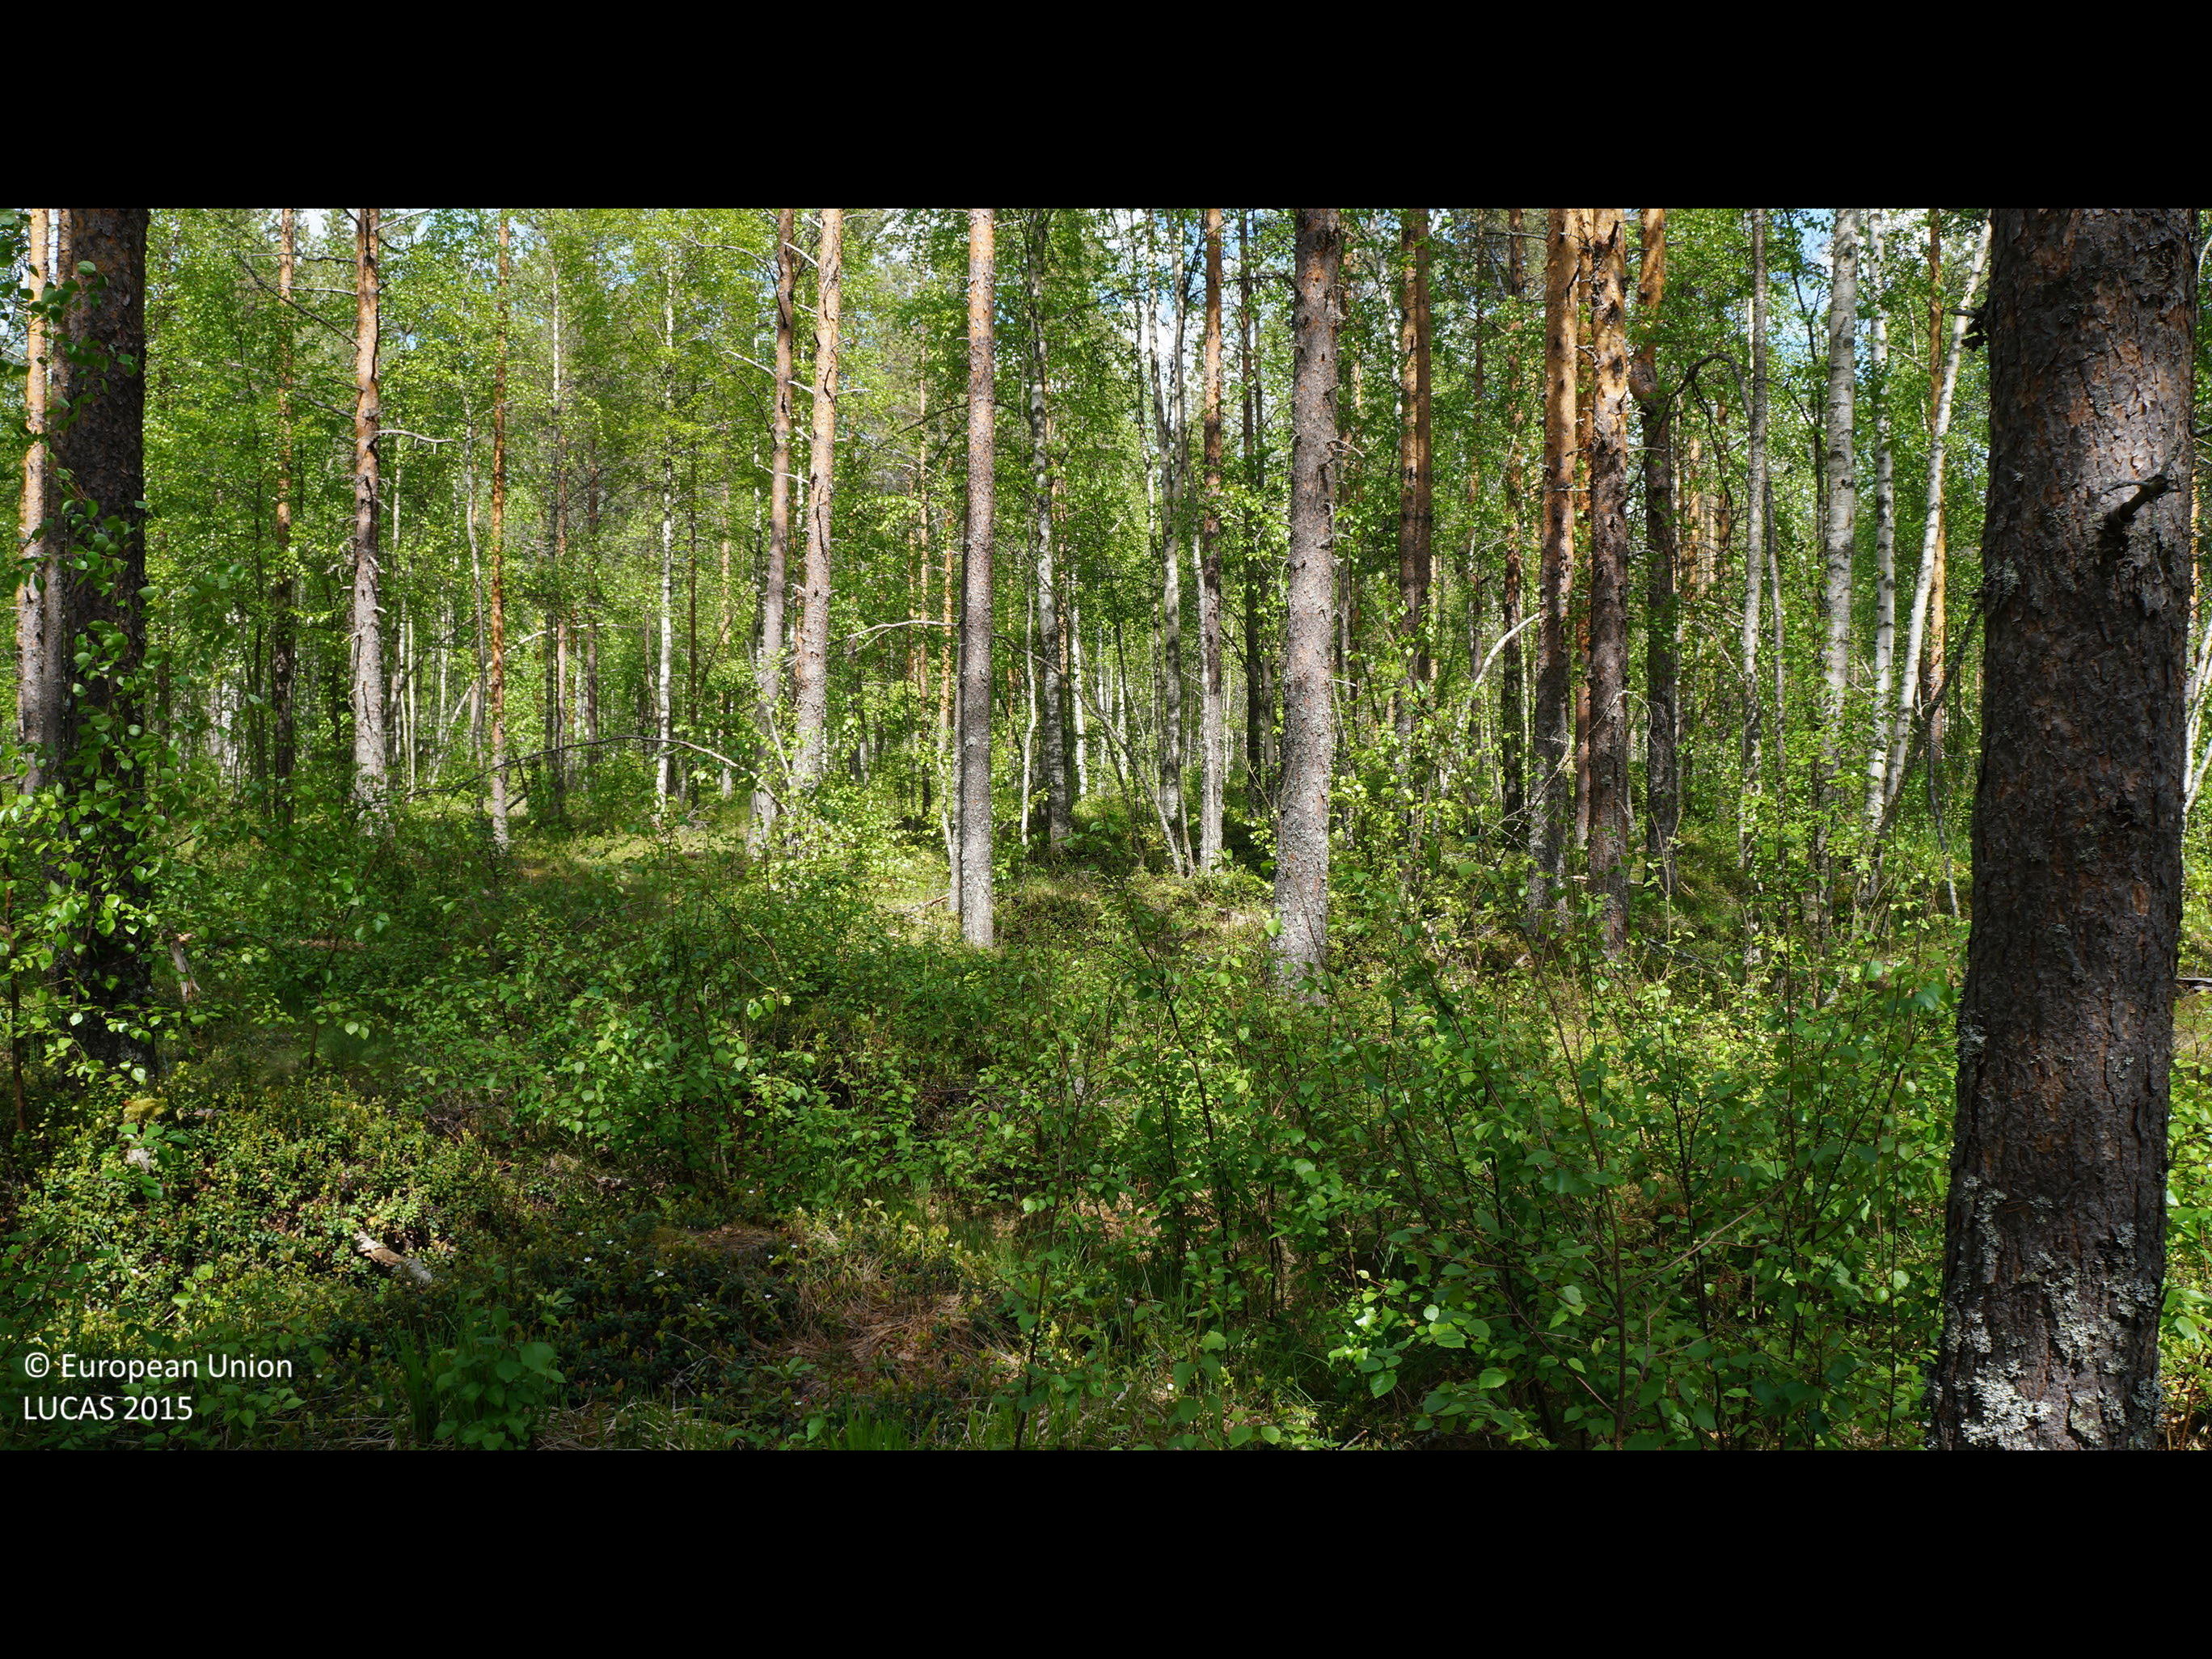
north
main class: Woodland
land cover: Pine dominated mixed woodland
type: boreal forest
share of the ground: > 75 %
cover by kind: coniferous forest trees 50 %, broadleaved forest trees 25 %, shrubs 10 %, herbaceous plants 10 %, lichens and mosses 5 %
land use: Forestry
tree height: > 5 m
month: June
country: FI
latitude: 64.1057
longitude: 25.1719
